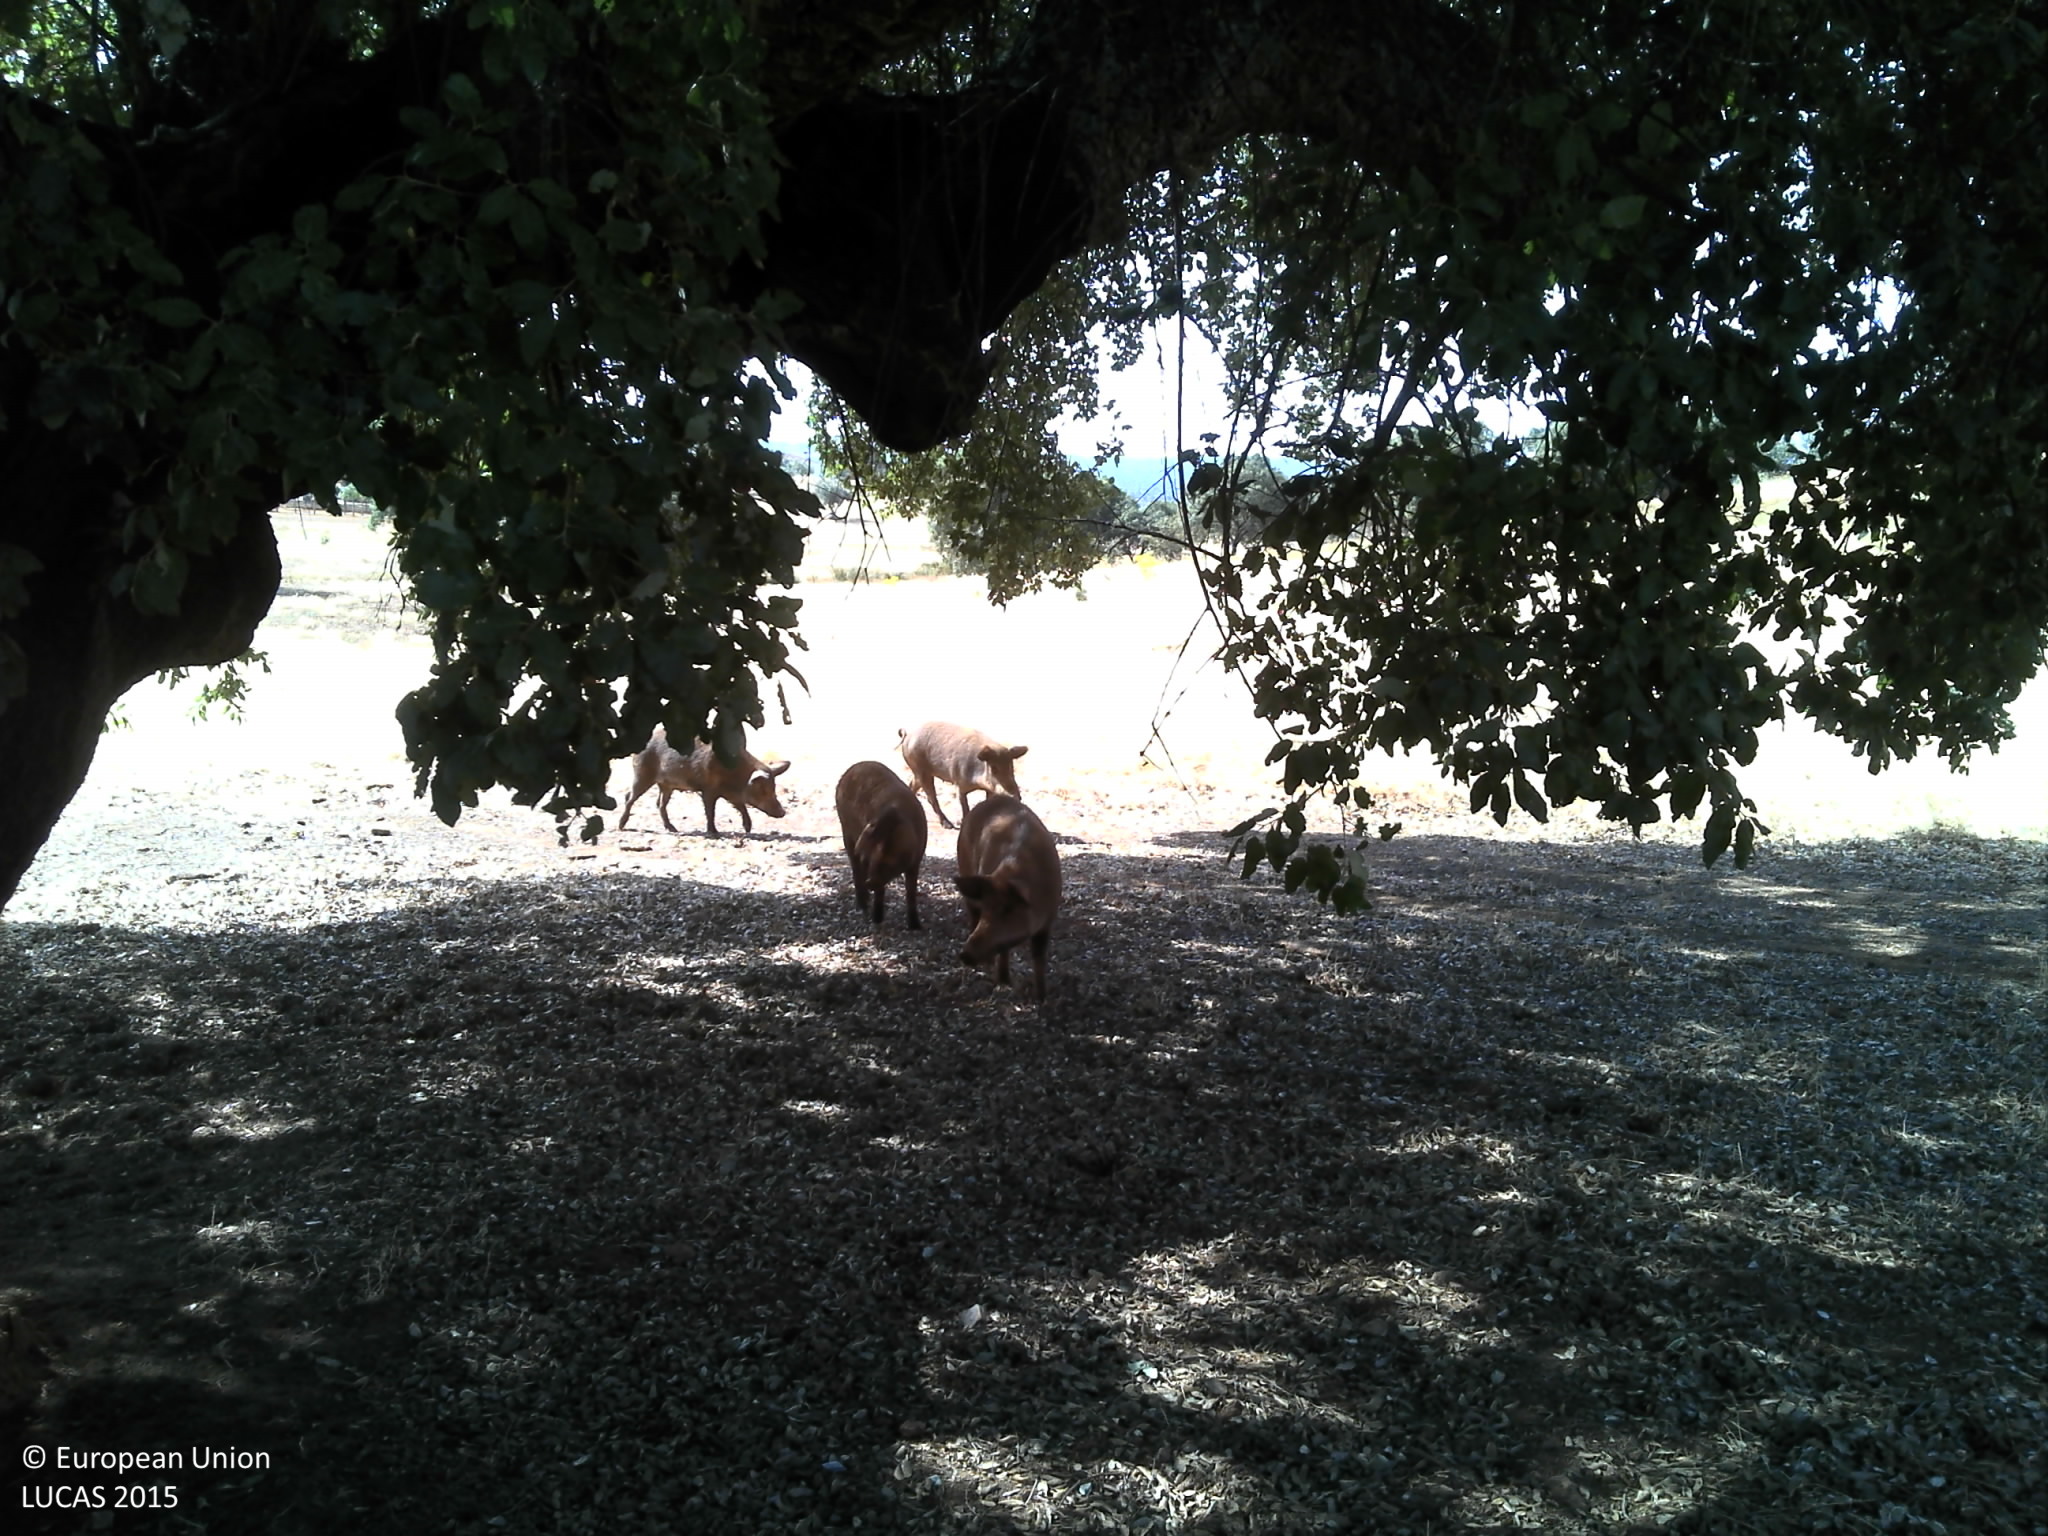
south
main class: Woodland
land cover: Broadleaved woodland
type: broadleaved evergreen forest
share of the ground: 10 - 25 %
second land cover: Spontaneously vegetated surfaces
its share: 10 - 25 %
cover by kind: unconsolidated bare surface 80 %, broadleaved forest trees 10 %, herbaceous plants 10 %
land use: Forestry
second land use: Agriculture (excluding fallow land and kitchen gardens)
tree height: > 5 m
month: July
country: PT
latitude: 38.3337
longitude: -7.7754
